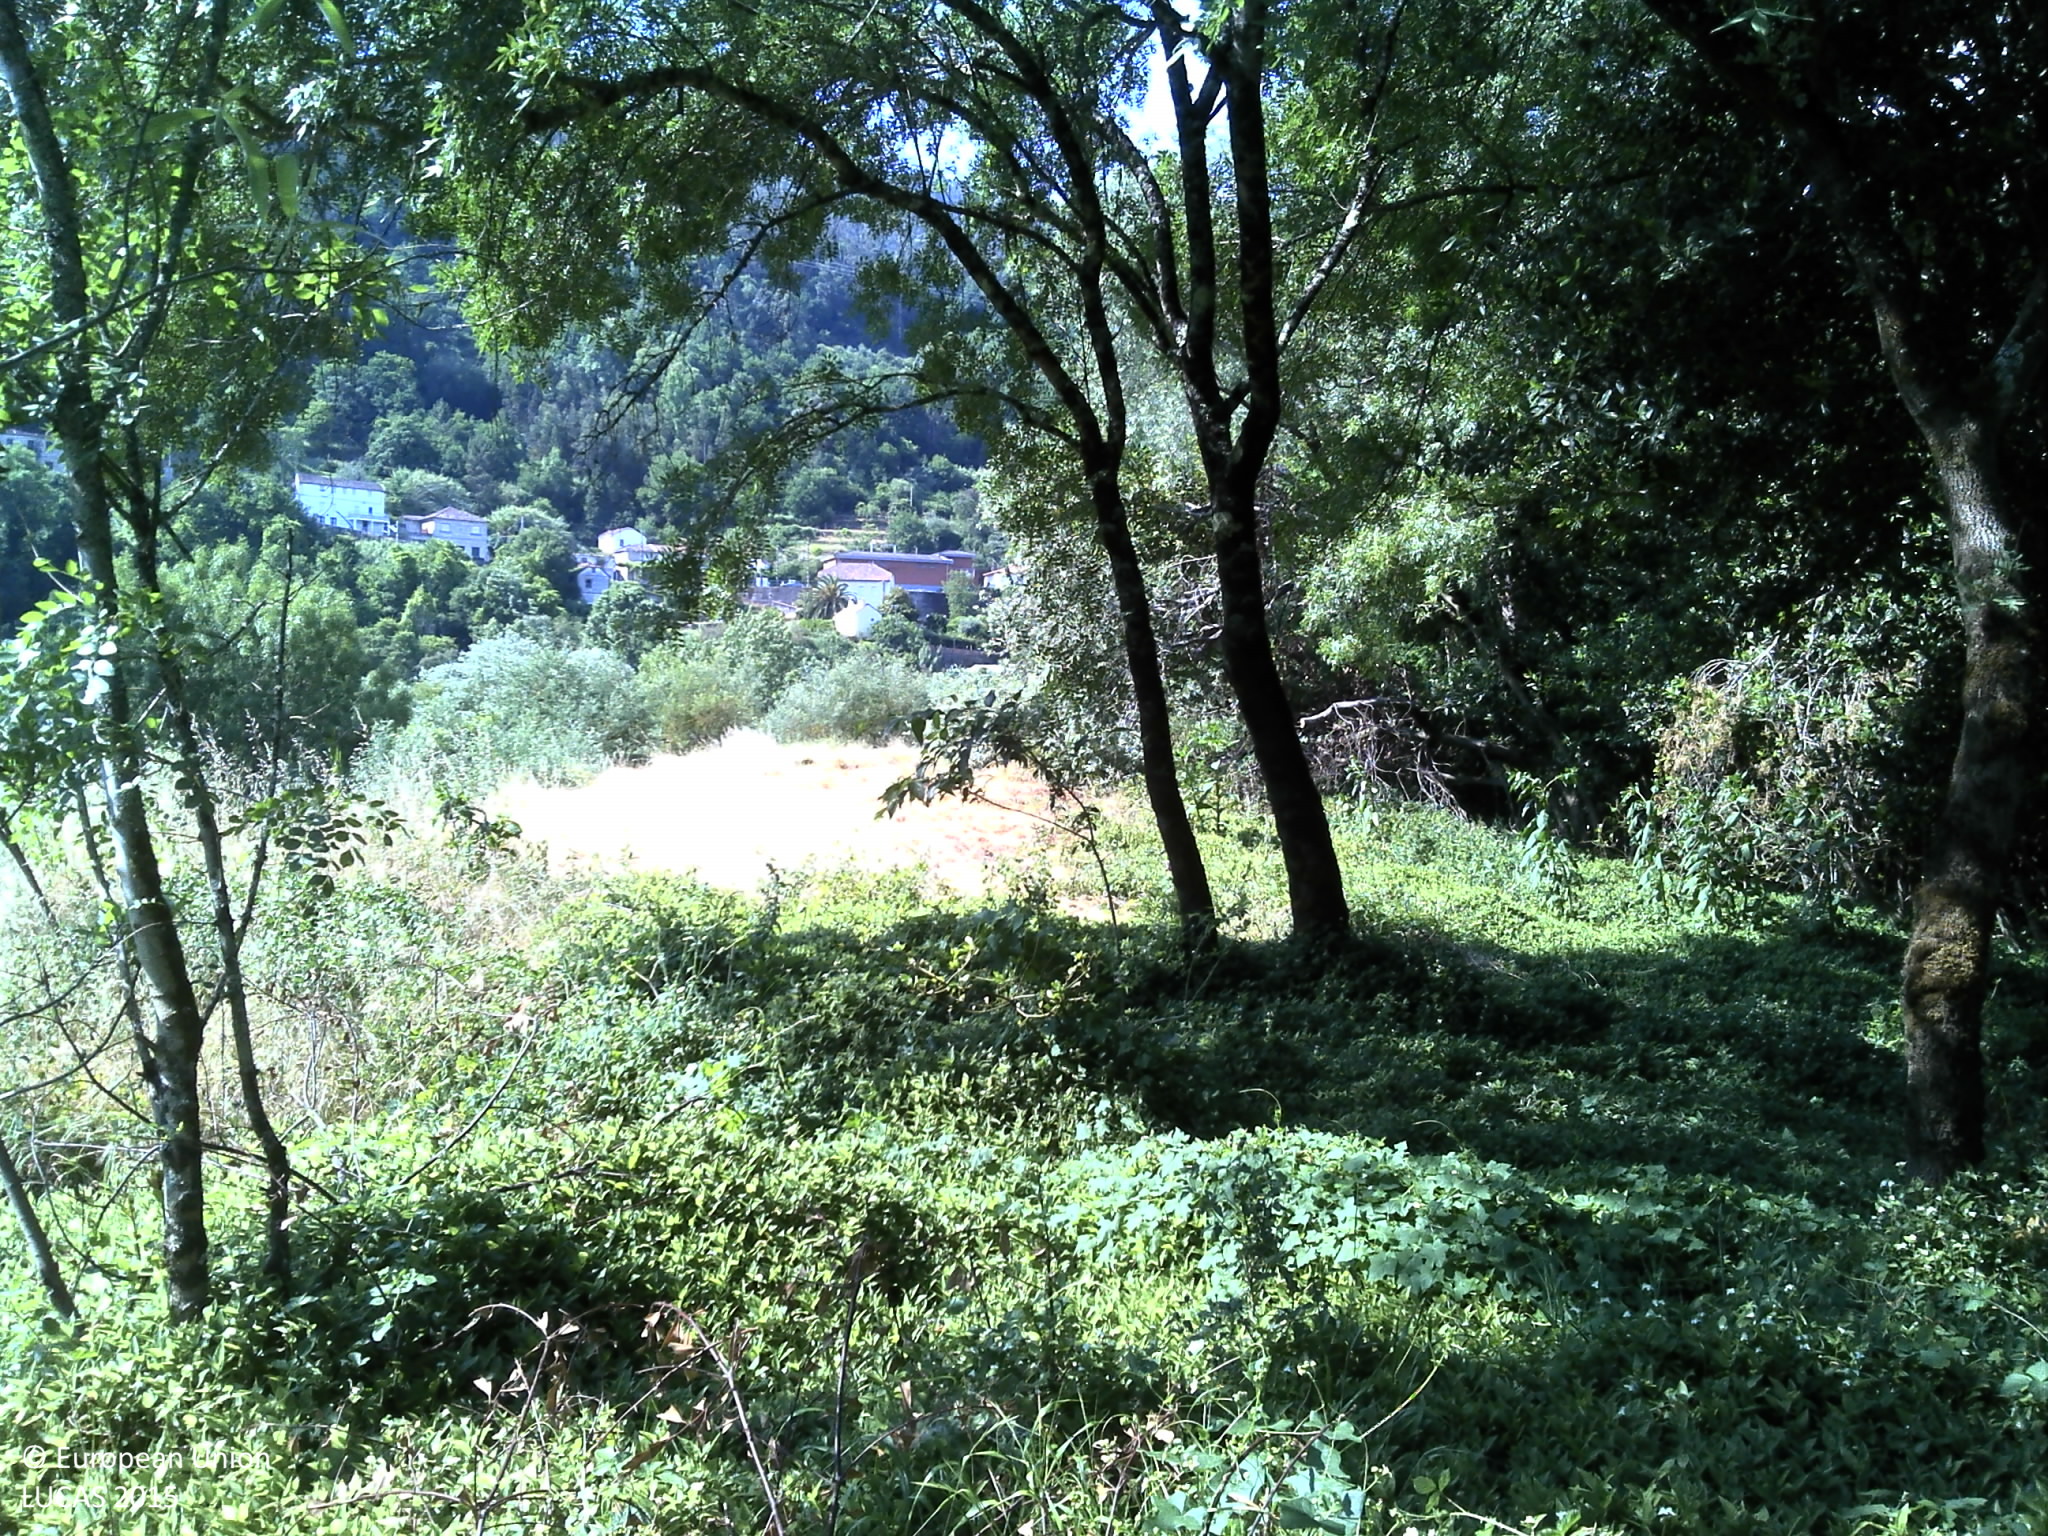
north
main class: Woodland
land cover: Broadleaved woodland
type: floodplain forest
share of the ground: > 75 %
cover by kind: broadleaved forest trees 70 %, unconsolidated bare surface 15 %, herbaceous plants 10 %, shrubs 5 %
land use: Semi-natural and natural areas not in use
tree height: > 5 m
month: June
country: PT
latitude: 42.1519
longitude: -8.2003
